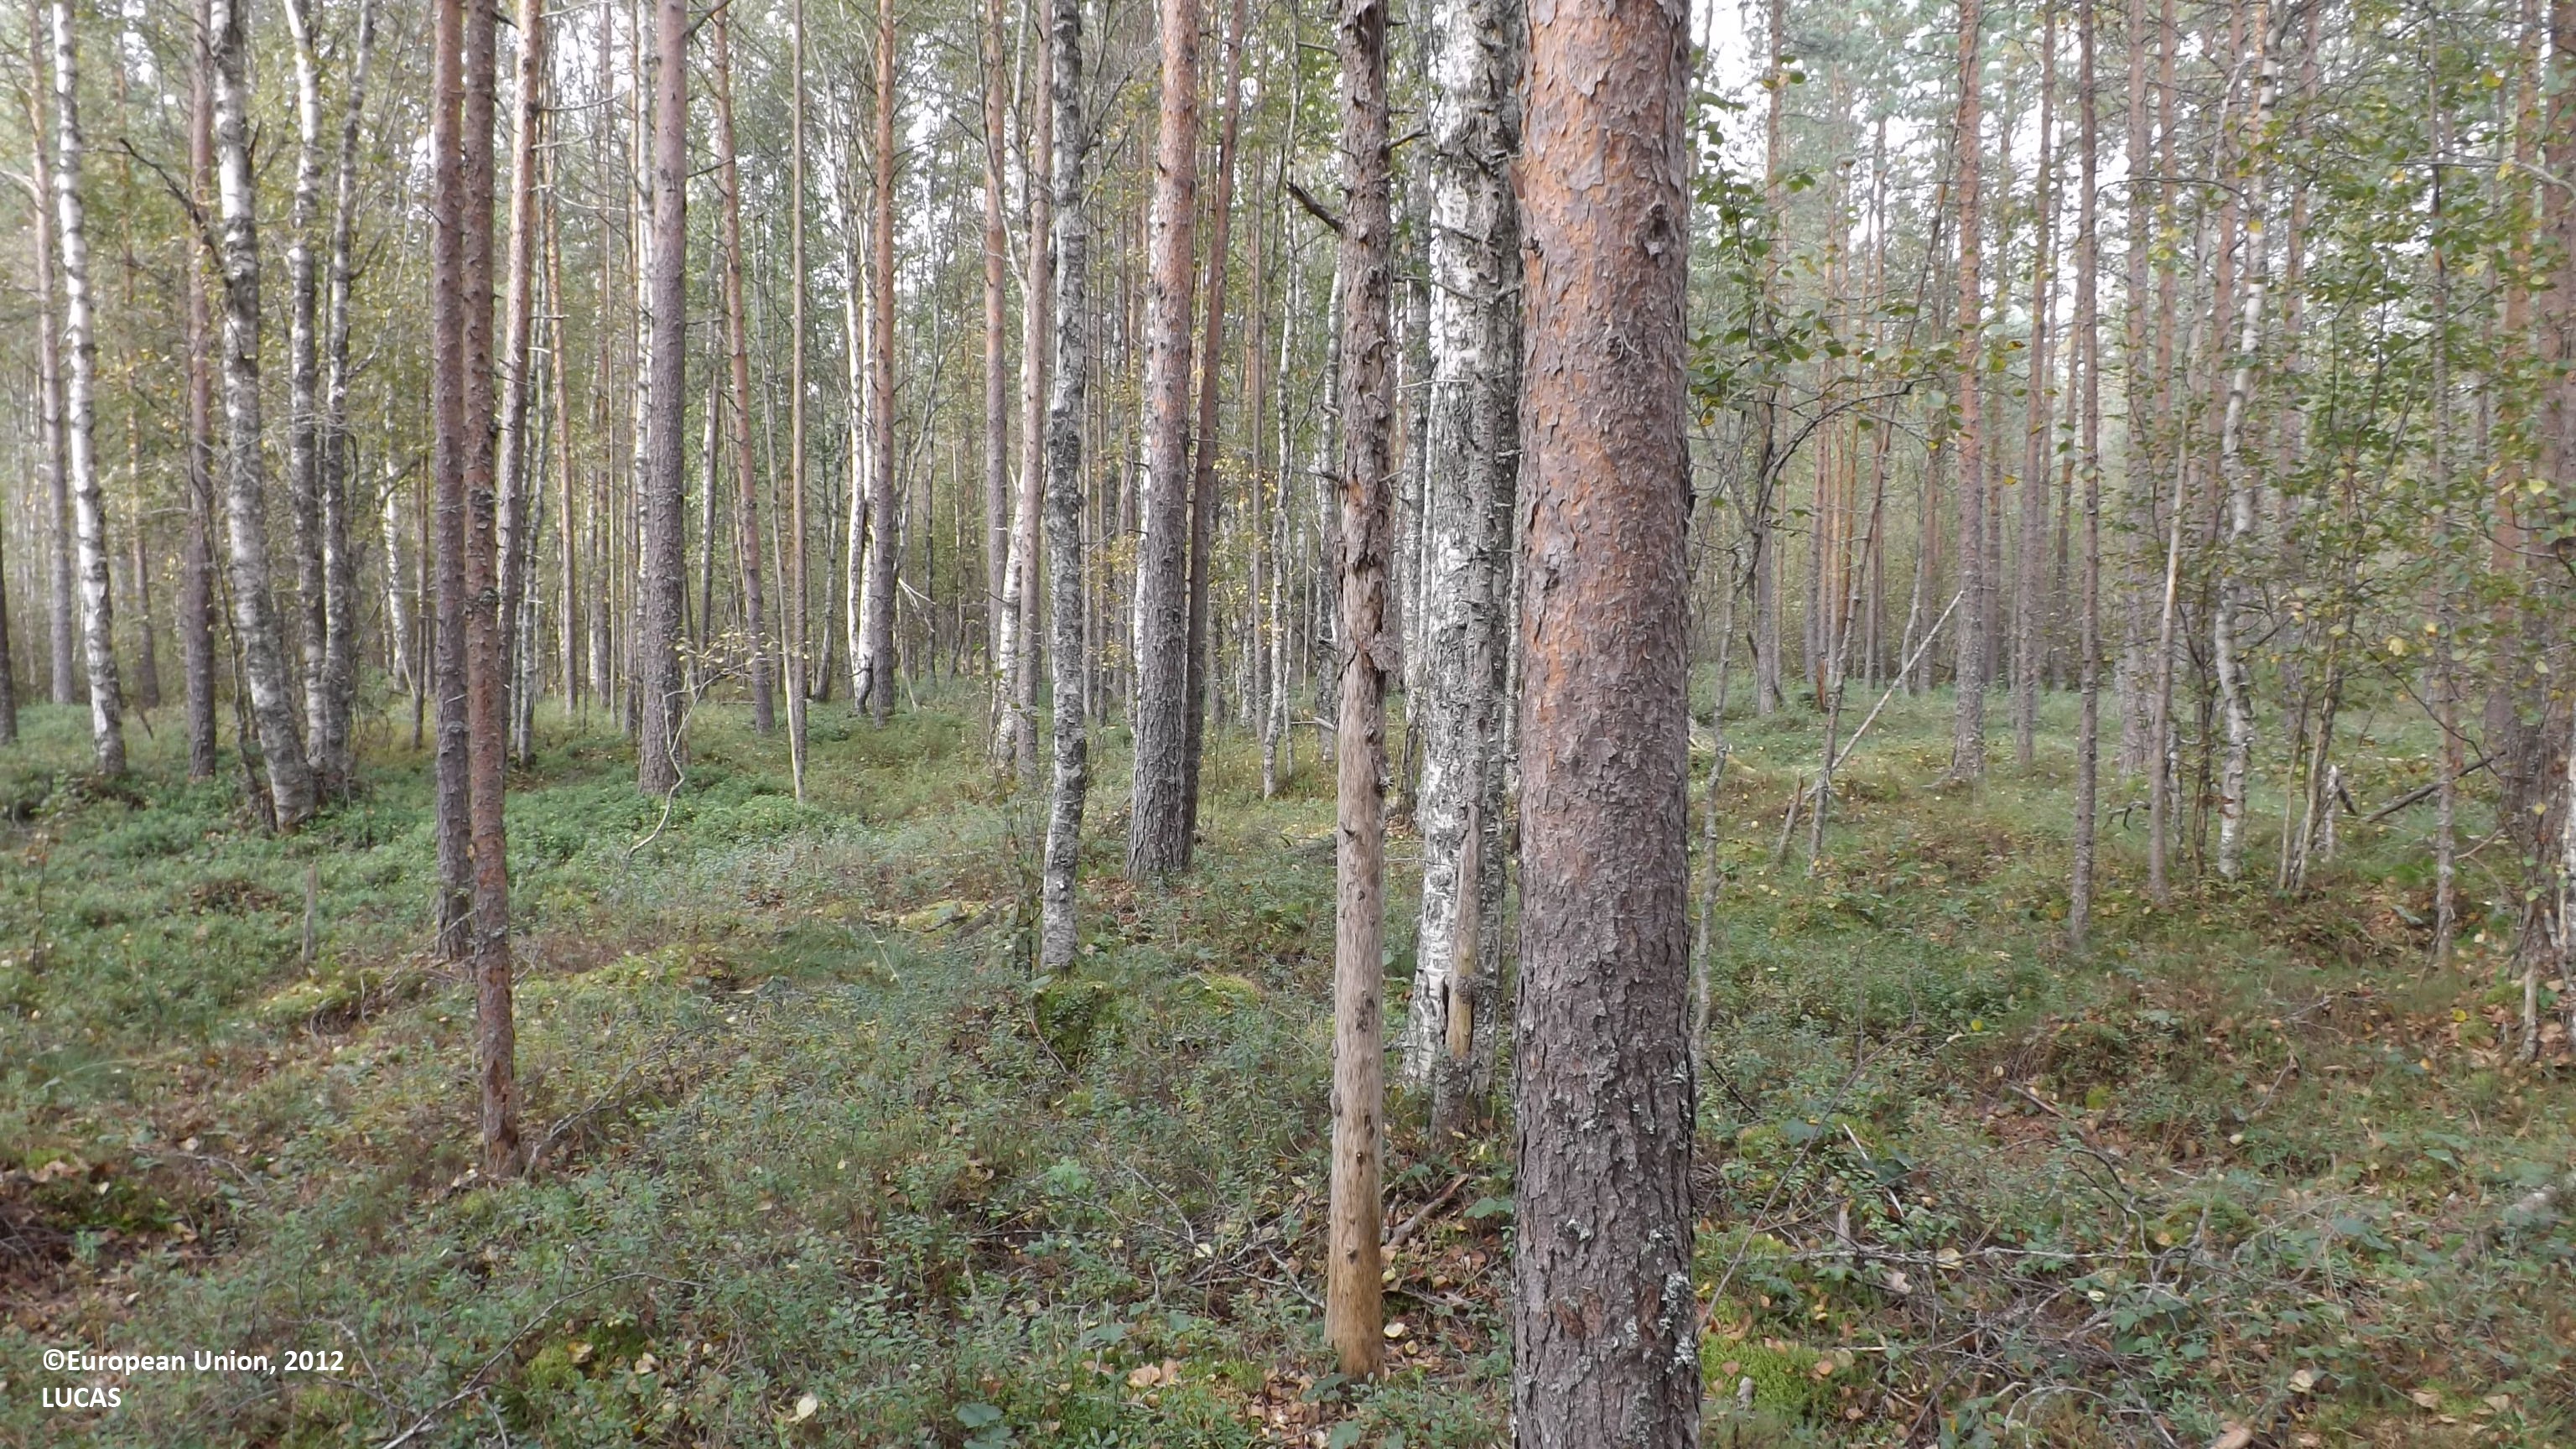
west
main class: Woodland
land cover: Pine dominated mixed woodland
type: boreal forest
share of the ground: 50 - 75 %
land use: Forestry
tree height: > 5 m
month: August
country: FI
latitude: 63.7419
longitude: 23.7385
